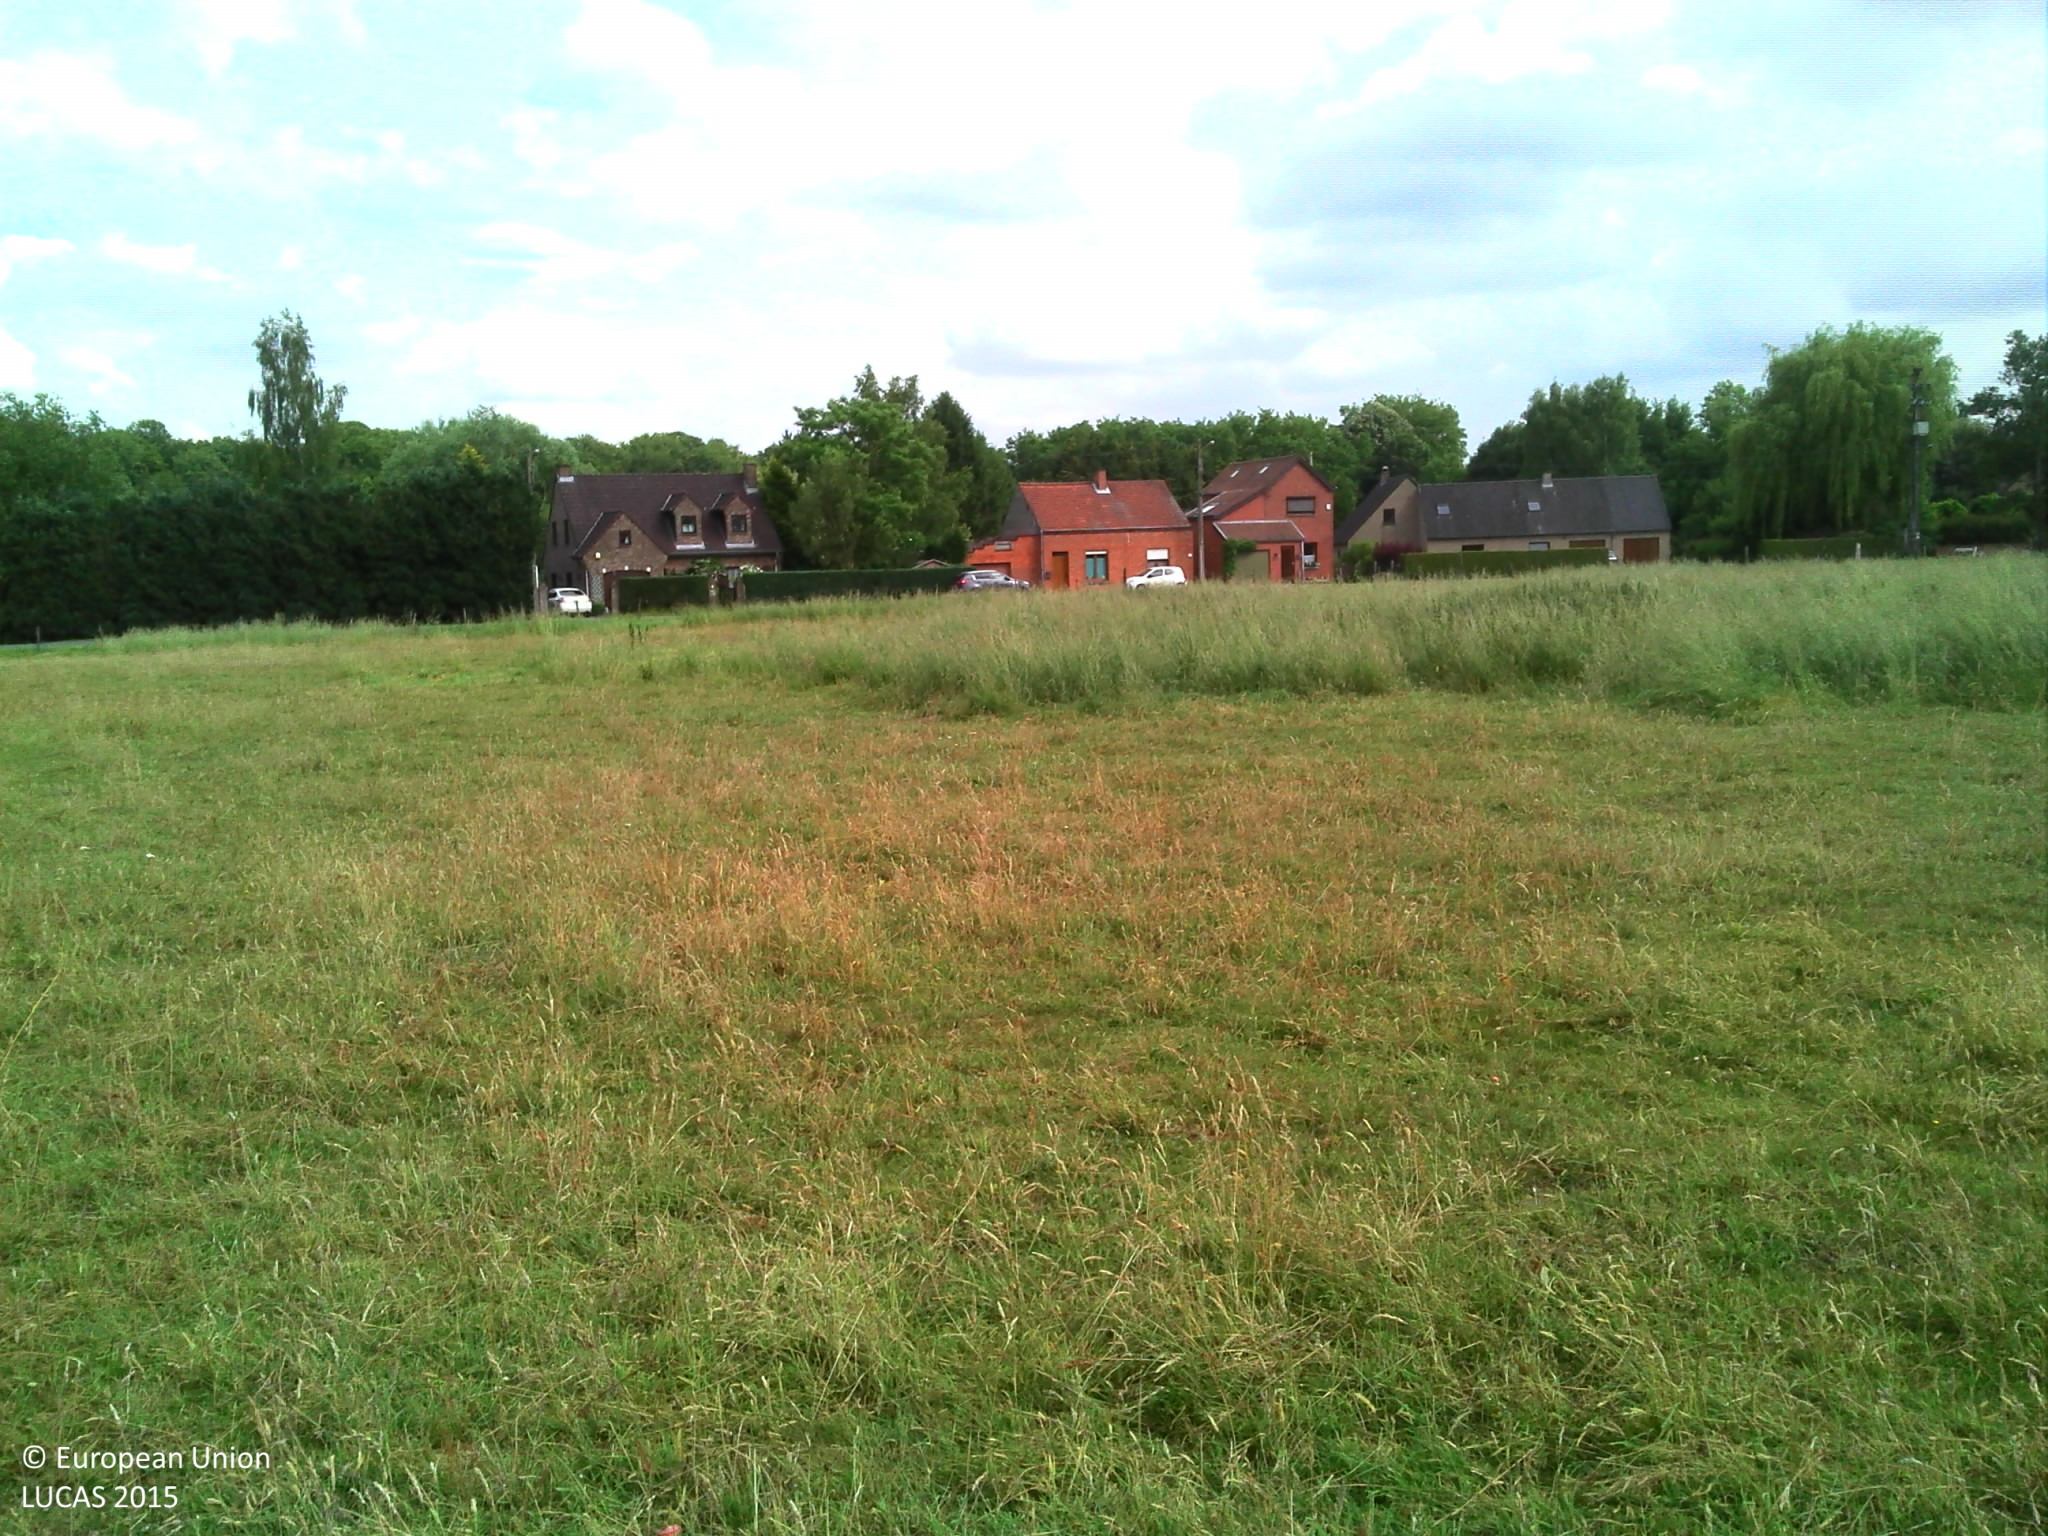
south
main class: Grassland
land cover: Grassland without tree/shrub cover
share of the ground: > 75 %
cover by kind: herbaceous plants 100 %
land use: Agriculture (excluding fallow land and kitchen gardens)
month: June
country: BE
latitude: 50.4908
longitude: 3.9187
